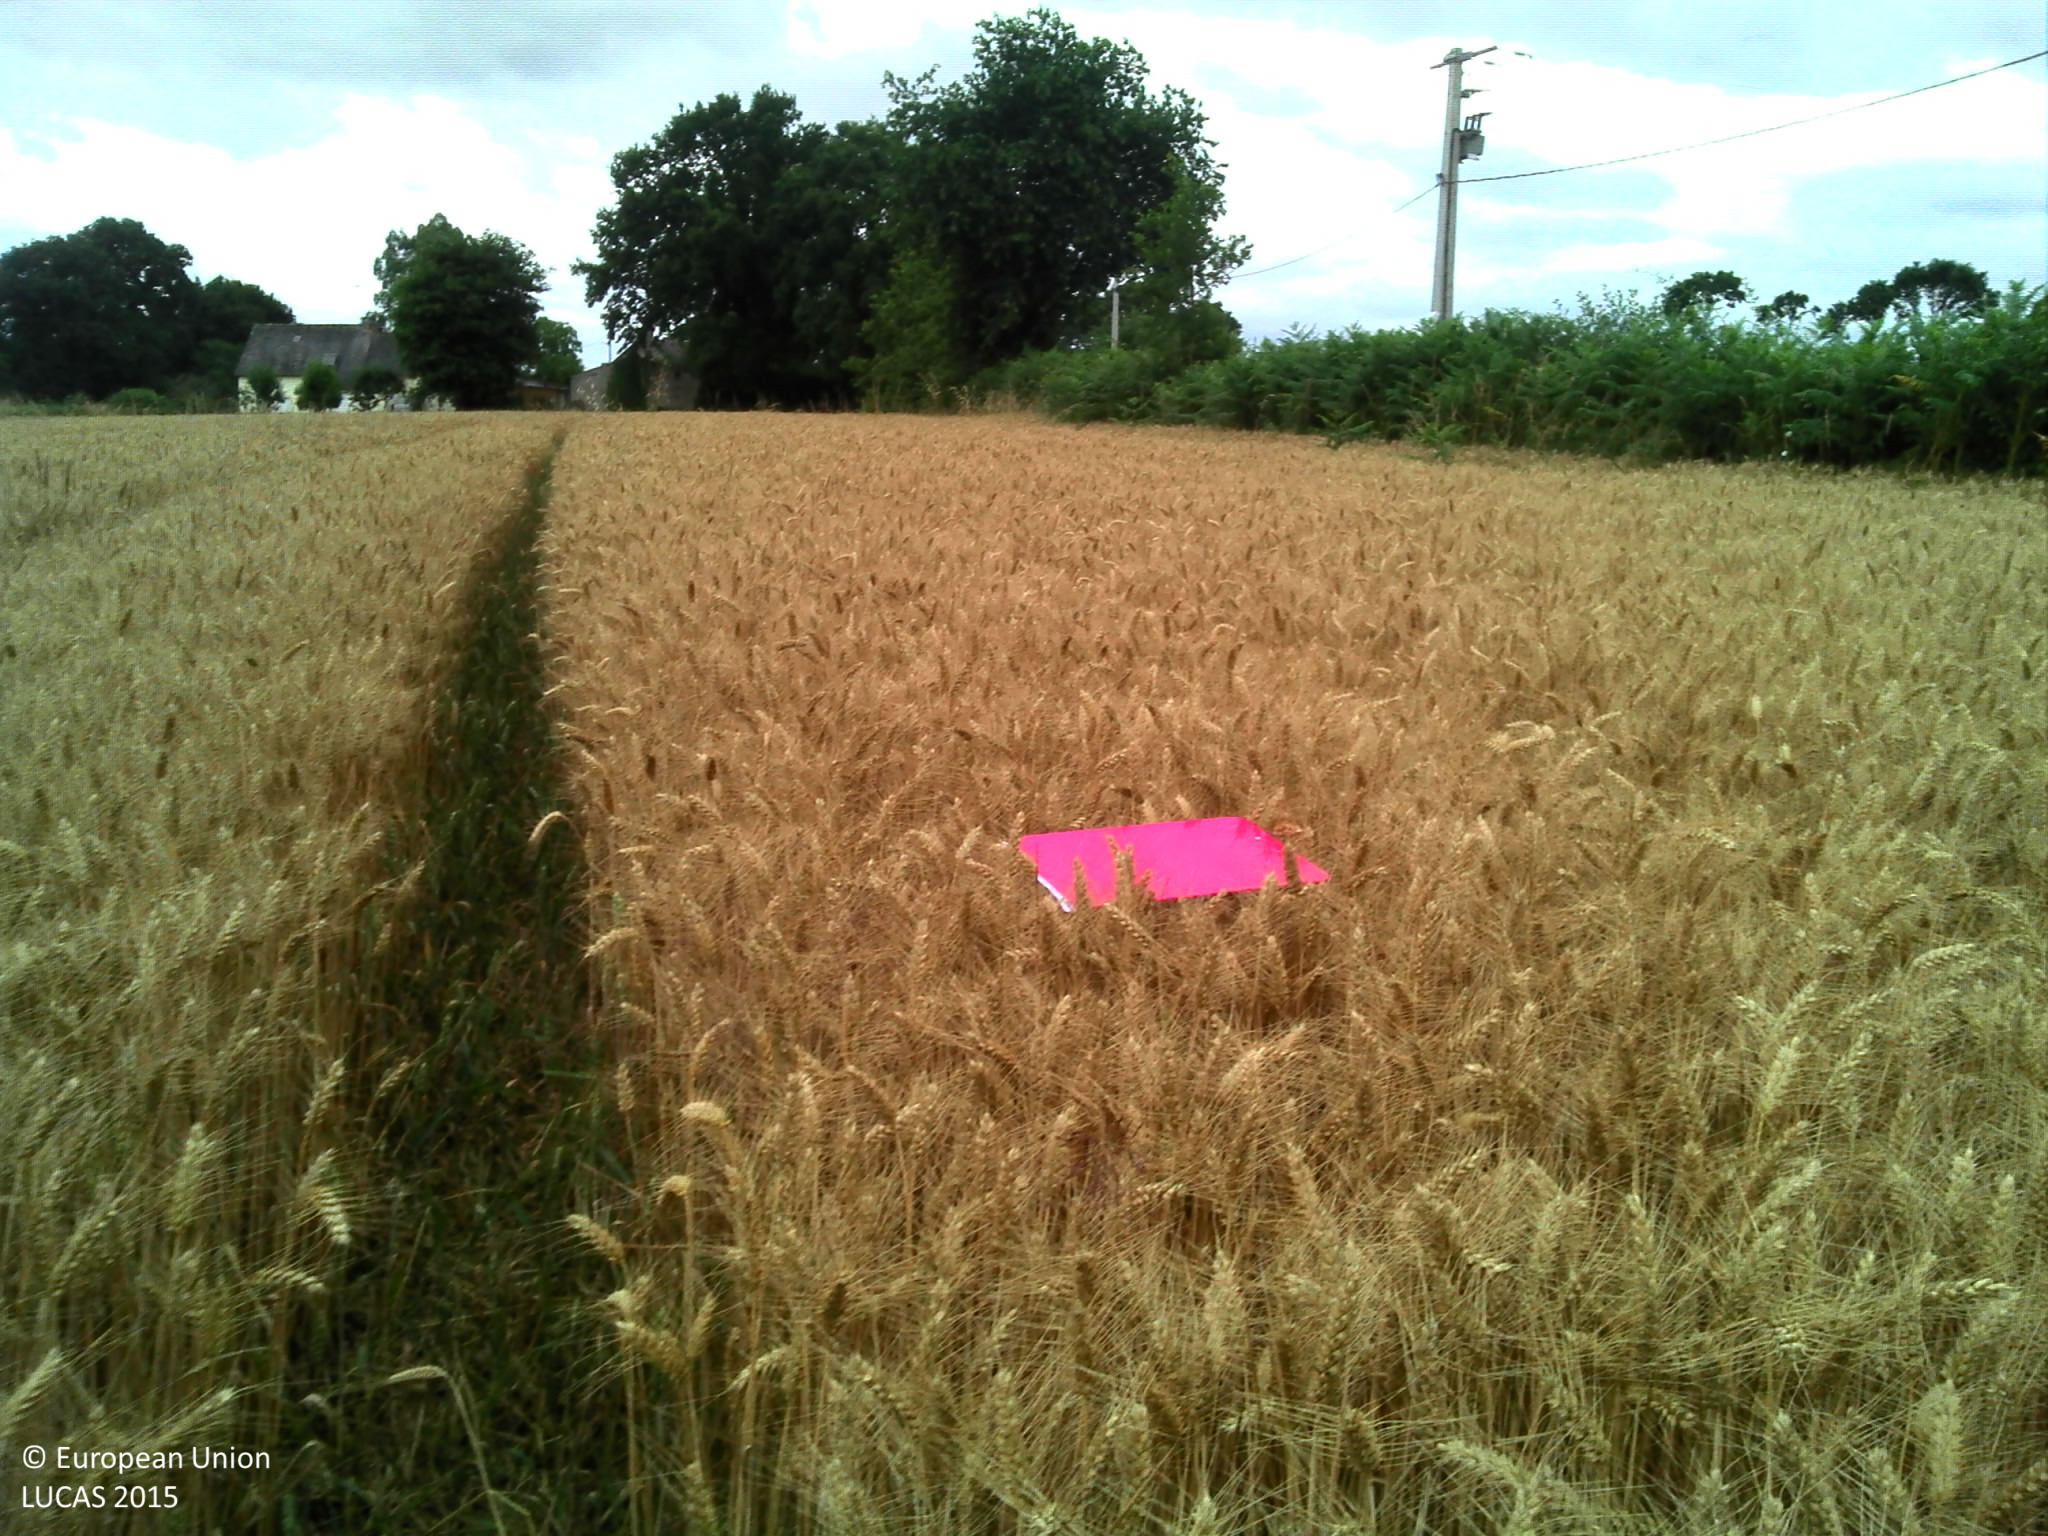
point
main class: Cropland
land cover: Durum wheat
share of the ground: > 75 %
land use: Agriculture (excluding fallow land and kitchen gardens)
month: July
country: FR
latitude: 47.7959
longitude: -2.0536
